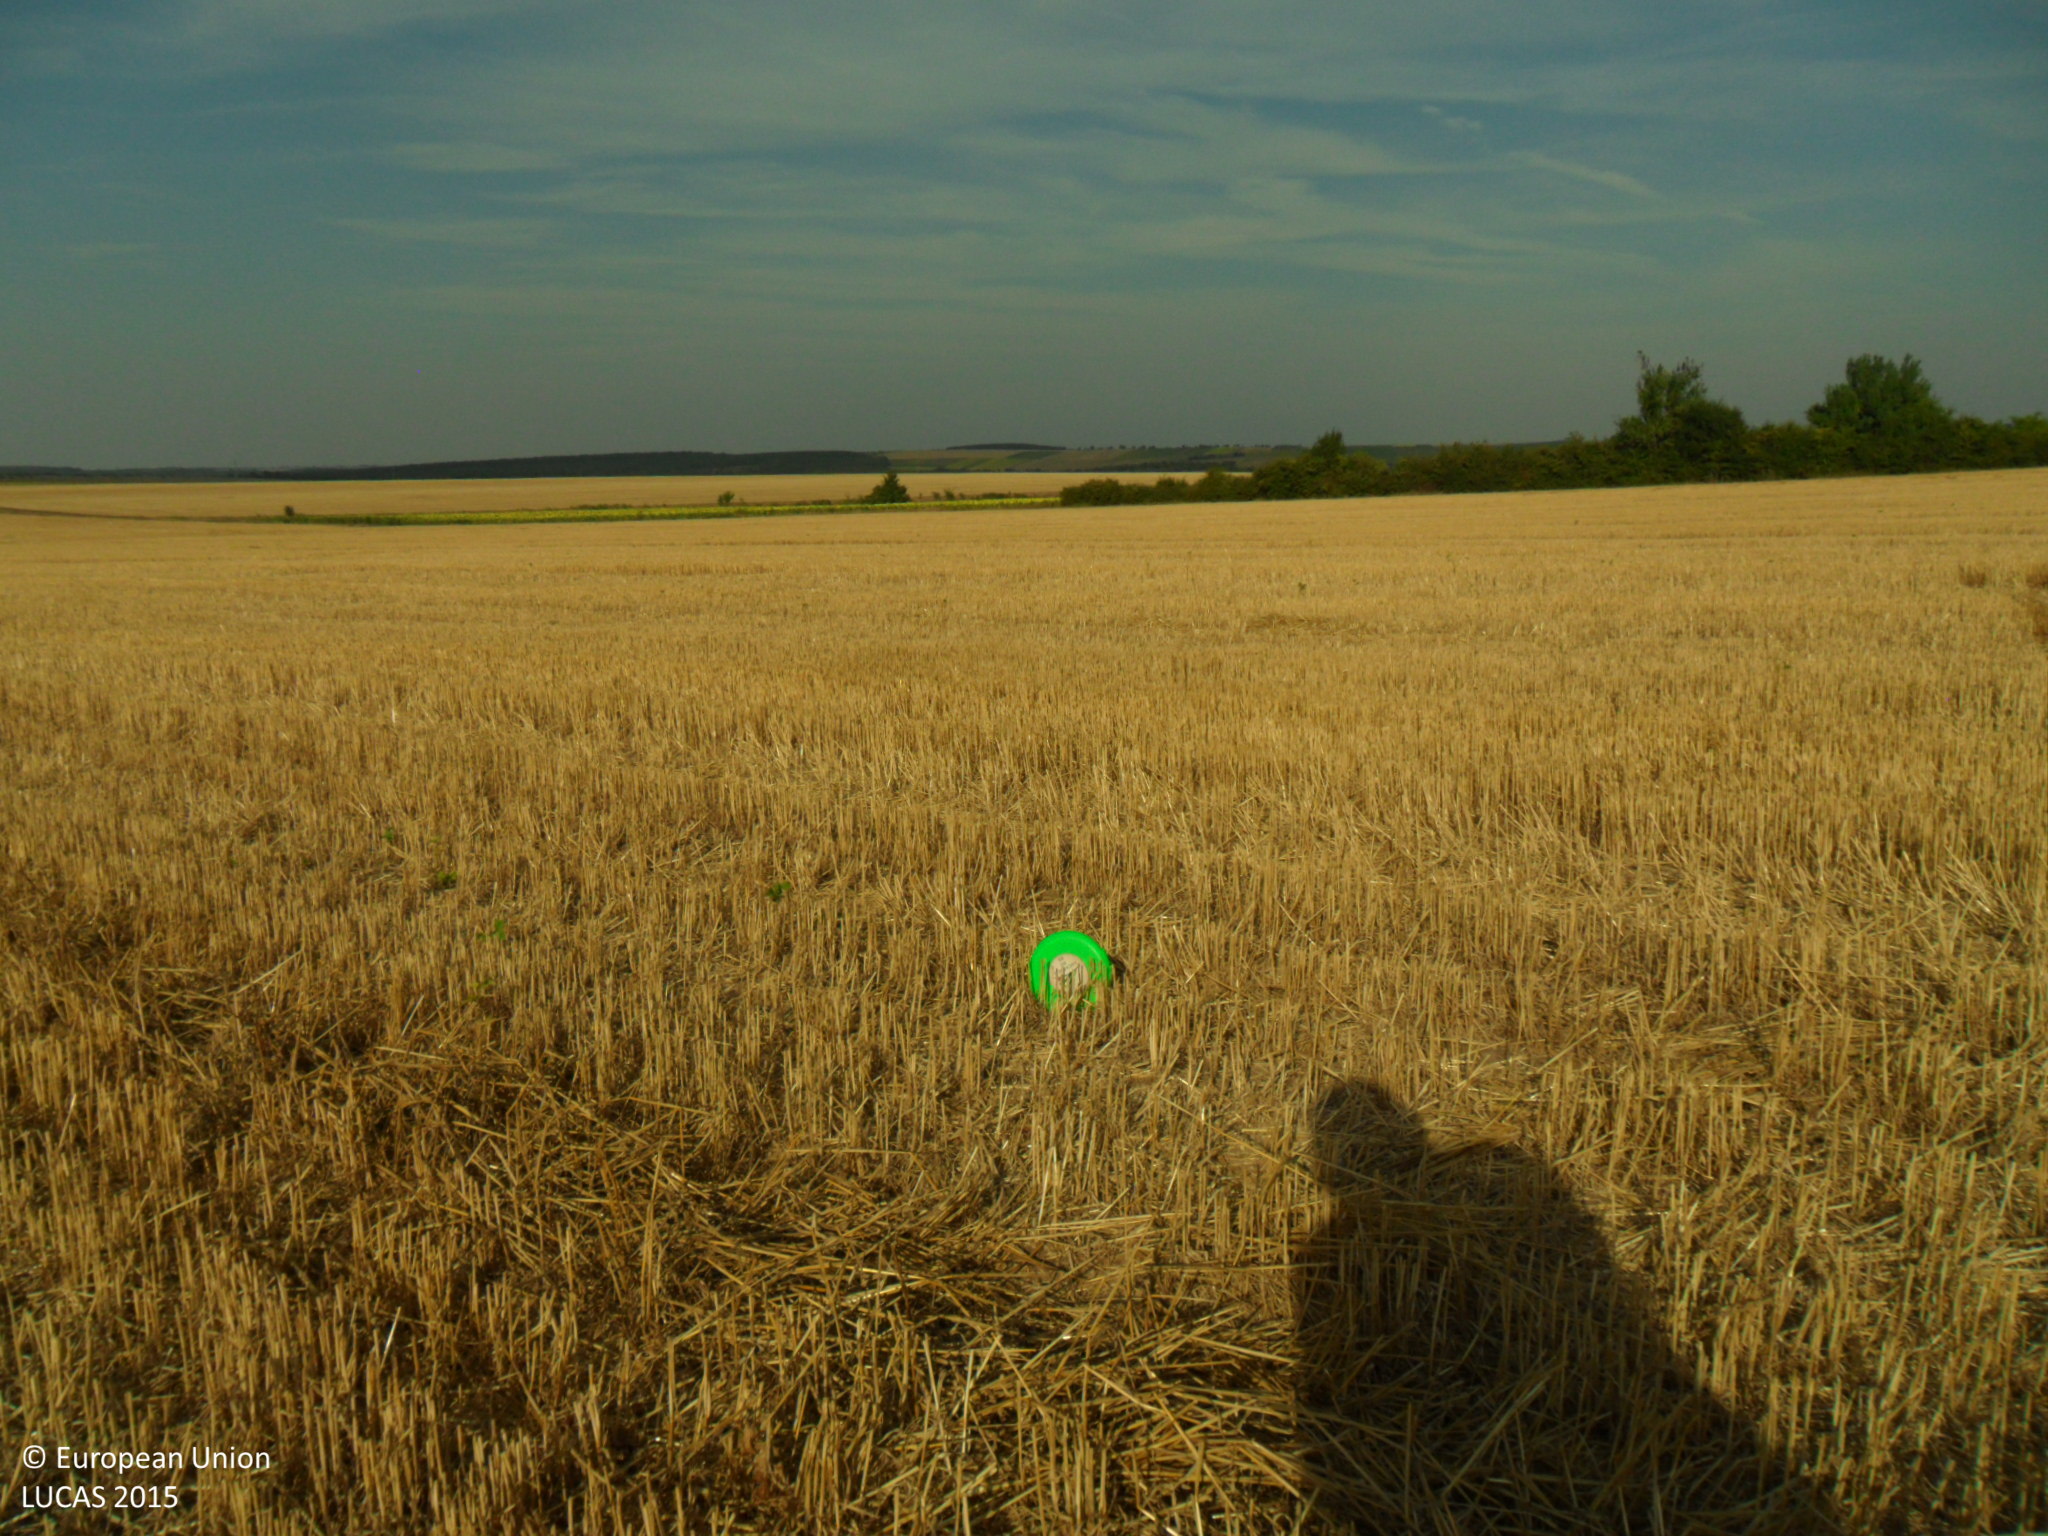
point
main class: Cropland
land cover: Common wheat
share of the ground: 25 - 50 %
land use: Agriculture (excluding fallow land and kitchen gardens)
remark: Harvested field
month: August
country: BG
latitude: 43.6510
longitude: 27.1207
